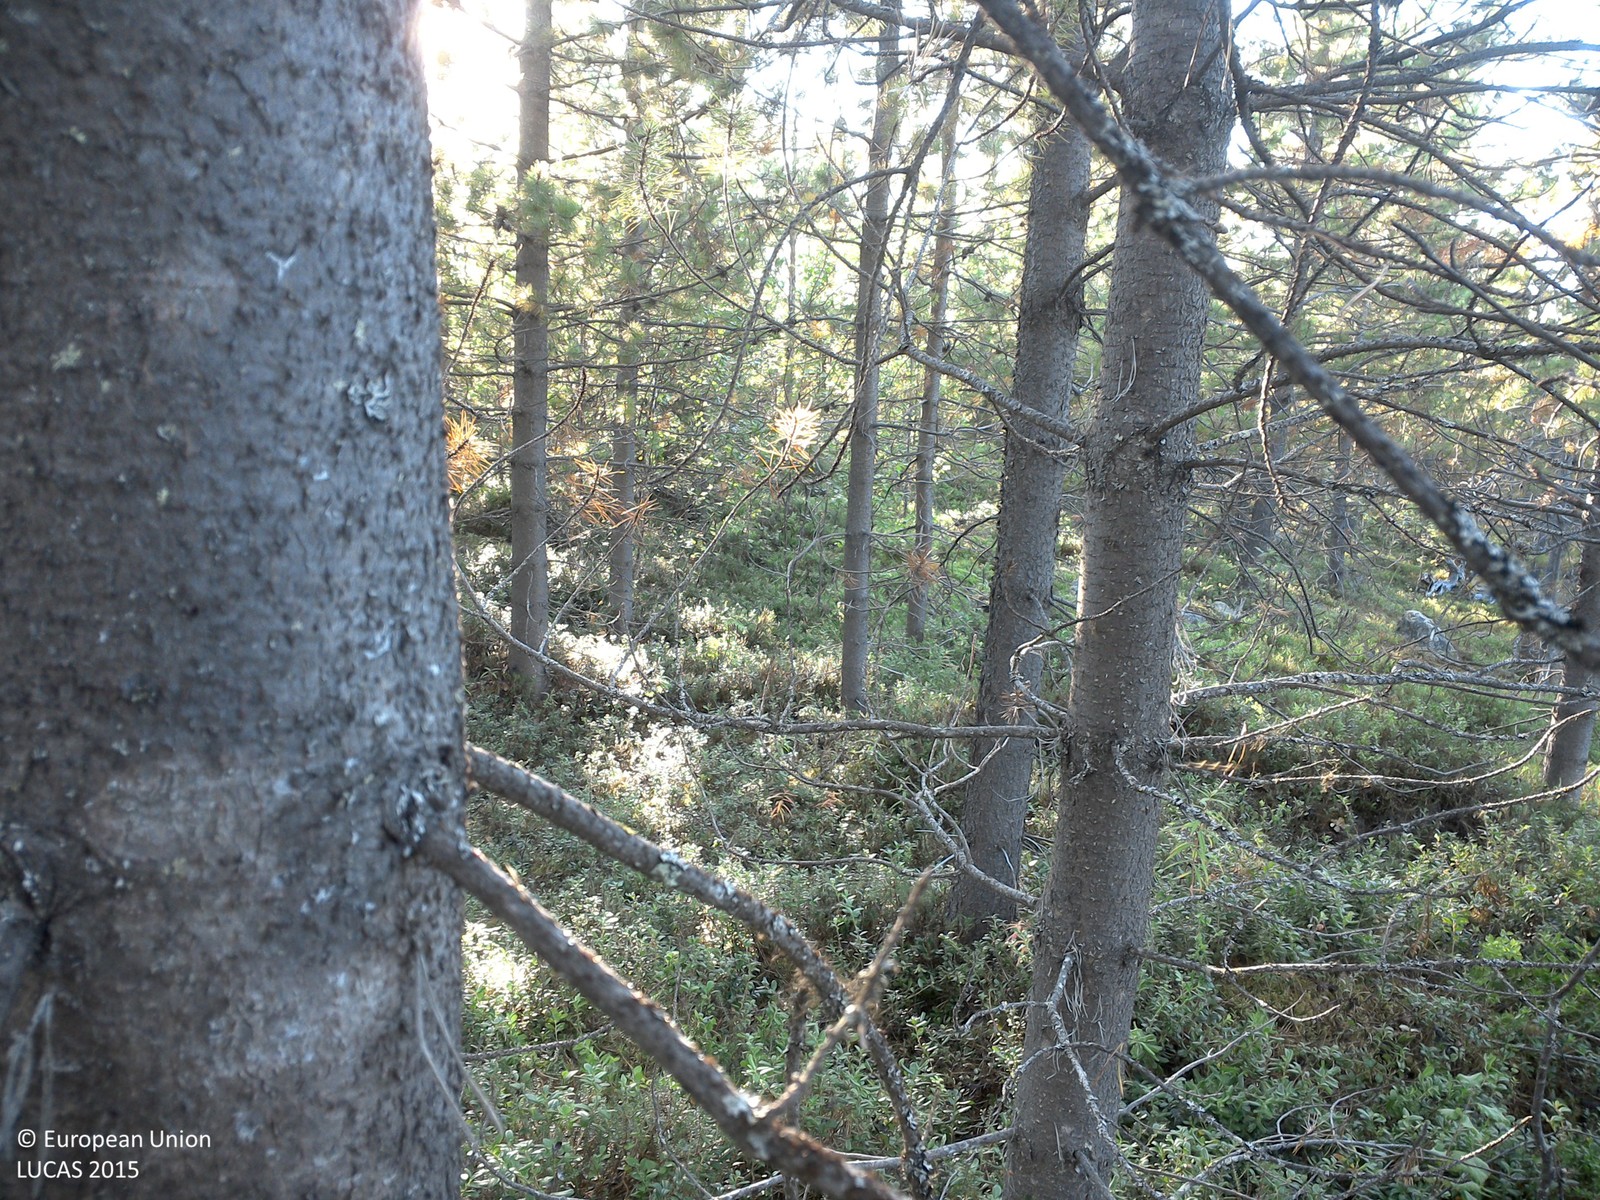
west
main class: Woodland
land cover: Pine dominated coniferous woodland
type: exotic forest
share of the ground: 50 - 75 %
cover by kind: coniferous forest trees 45 %, shrubs 45 %, broadleaved forest trees 5 %, lichens and mosses 5 %
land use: Forestry
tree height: > 5 m
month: August
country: SE
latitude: 67.0635
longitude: 21.6608
